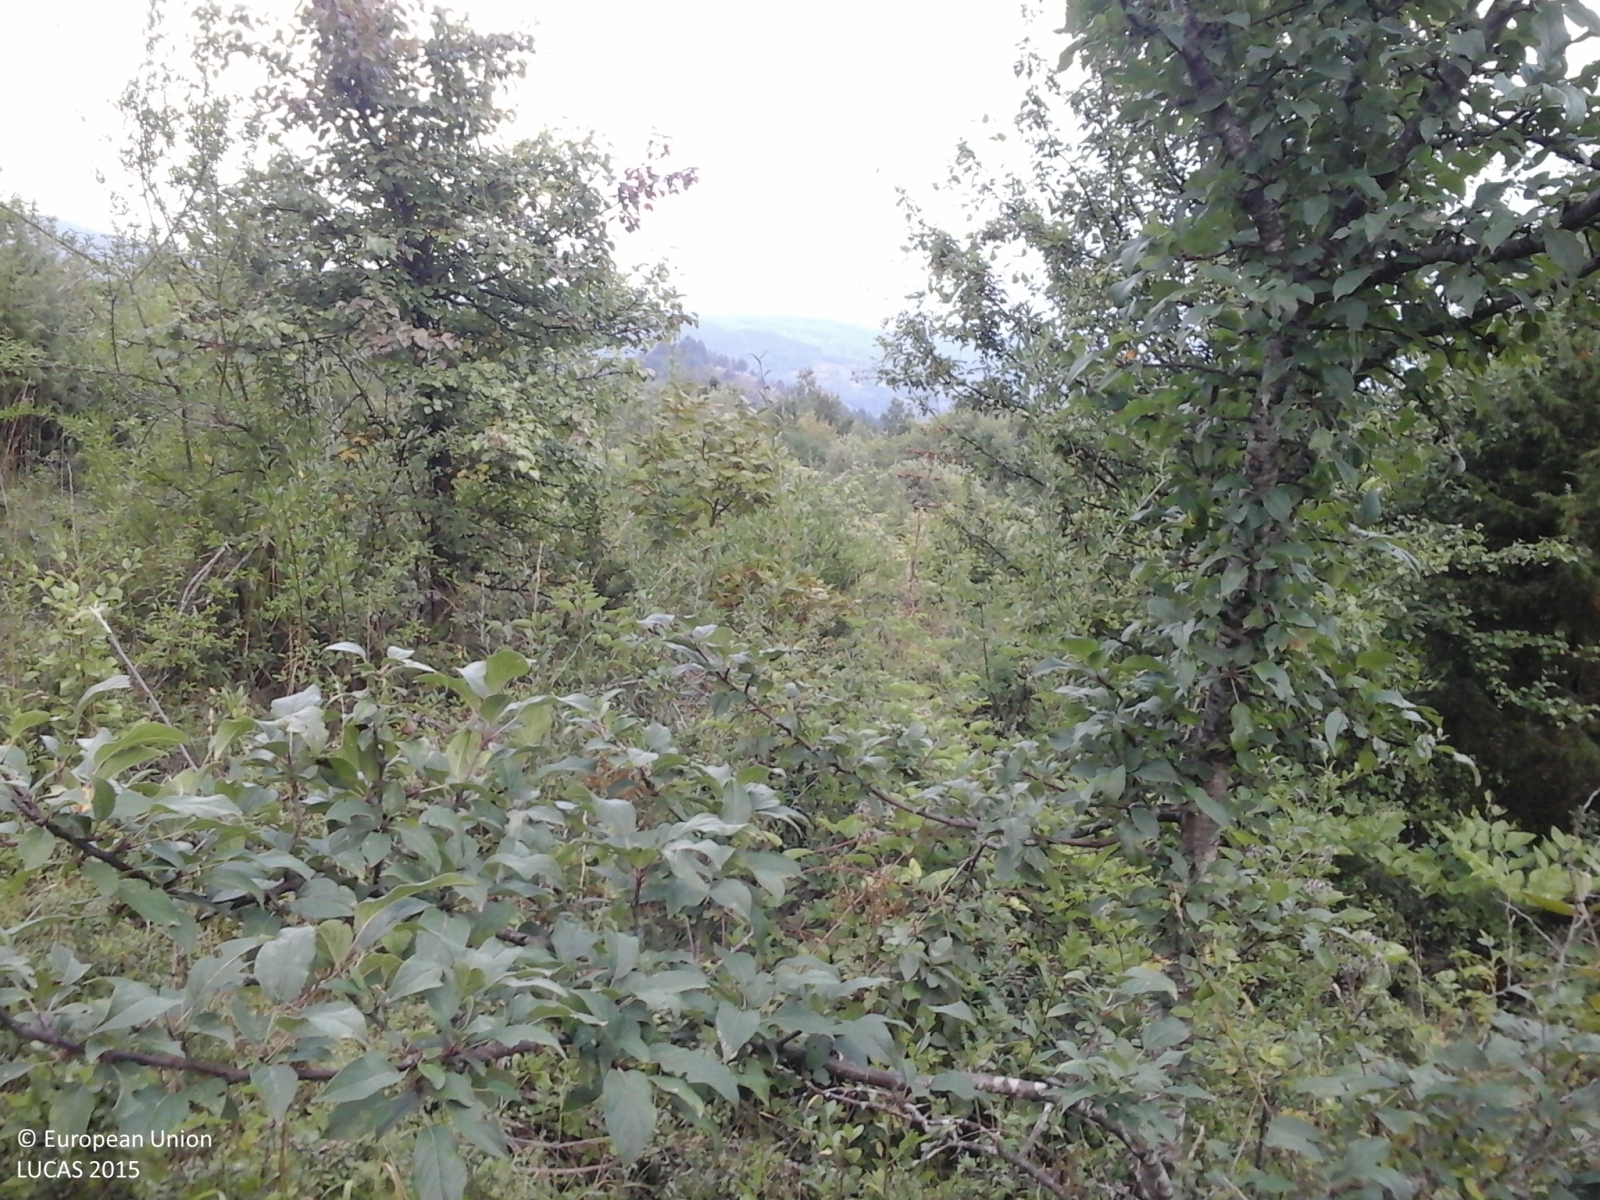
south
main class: Woodland
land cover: Broadleaved woodland
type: thermophilous deciduous forest
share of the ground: > 75 %
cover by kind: broadleaved forest trees 40 %, shrubs 40 %, herbaceous plants 15 %, coniferous forest trees 5 %
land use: Semi-natural and natural areas not in use
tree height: > 5 m
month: August
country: IT
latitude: 44.7450
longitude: 9.3068
